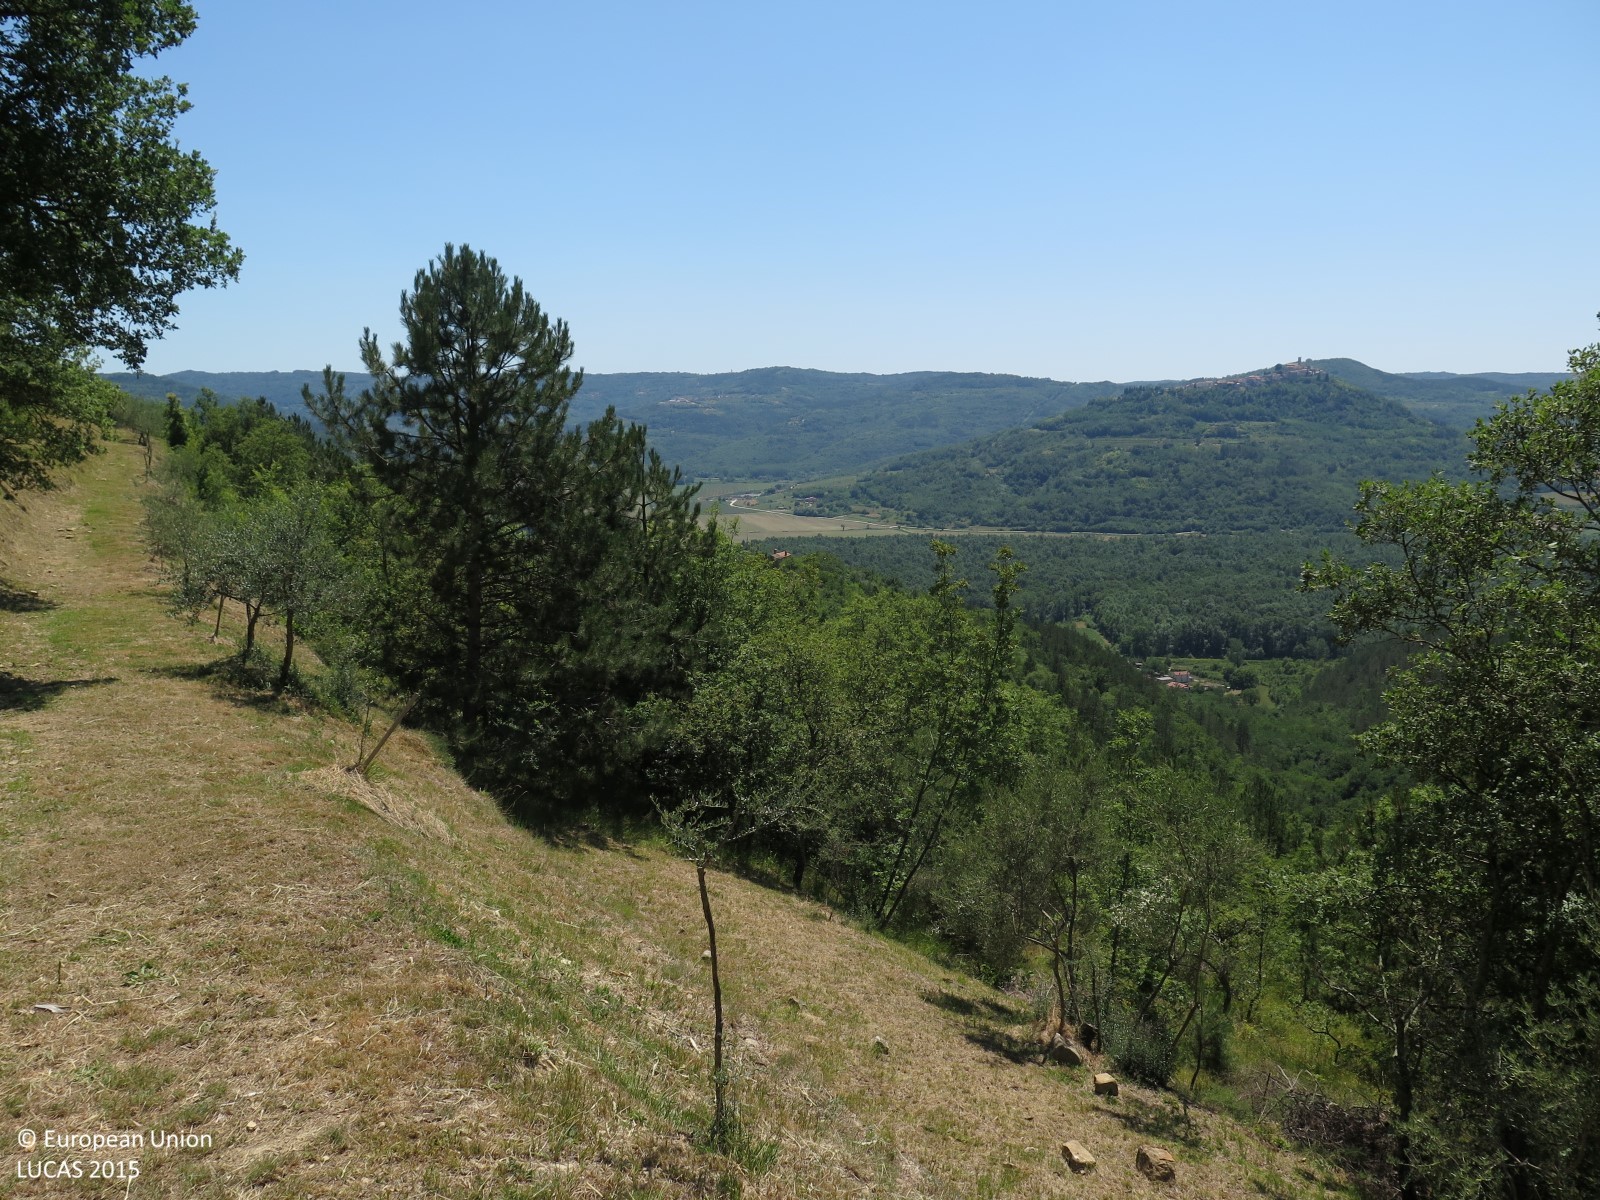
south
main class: Woodland
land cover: Pine dominated mixed woodland
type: coniferous forest of the mediterranean region
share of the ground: > 75 %
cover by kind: coniferous forest trees 75 %, broadleaved forest trees 25 %
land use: Semi-natural and natural areas not in use
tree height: > 5 m
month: July
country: HR
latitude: 45.3625
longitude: 13.8378
